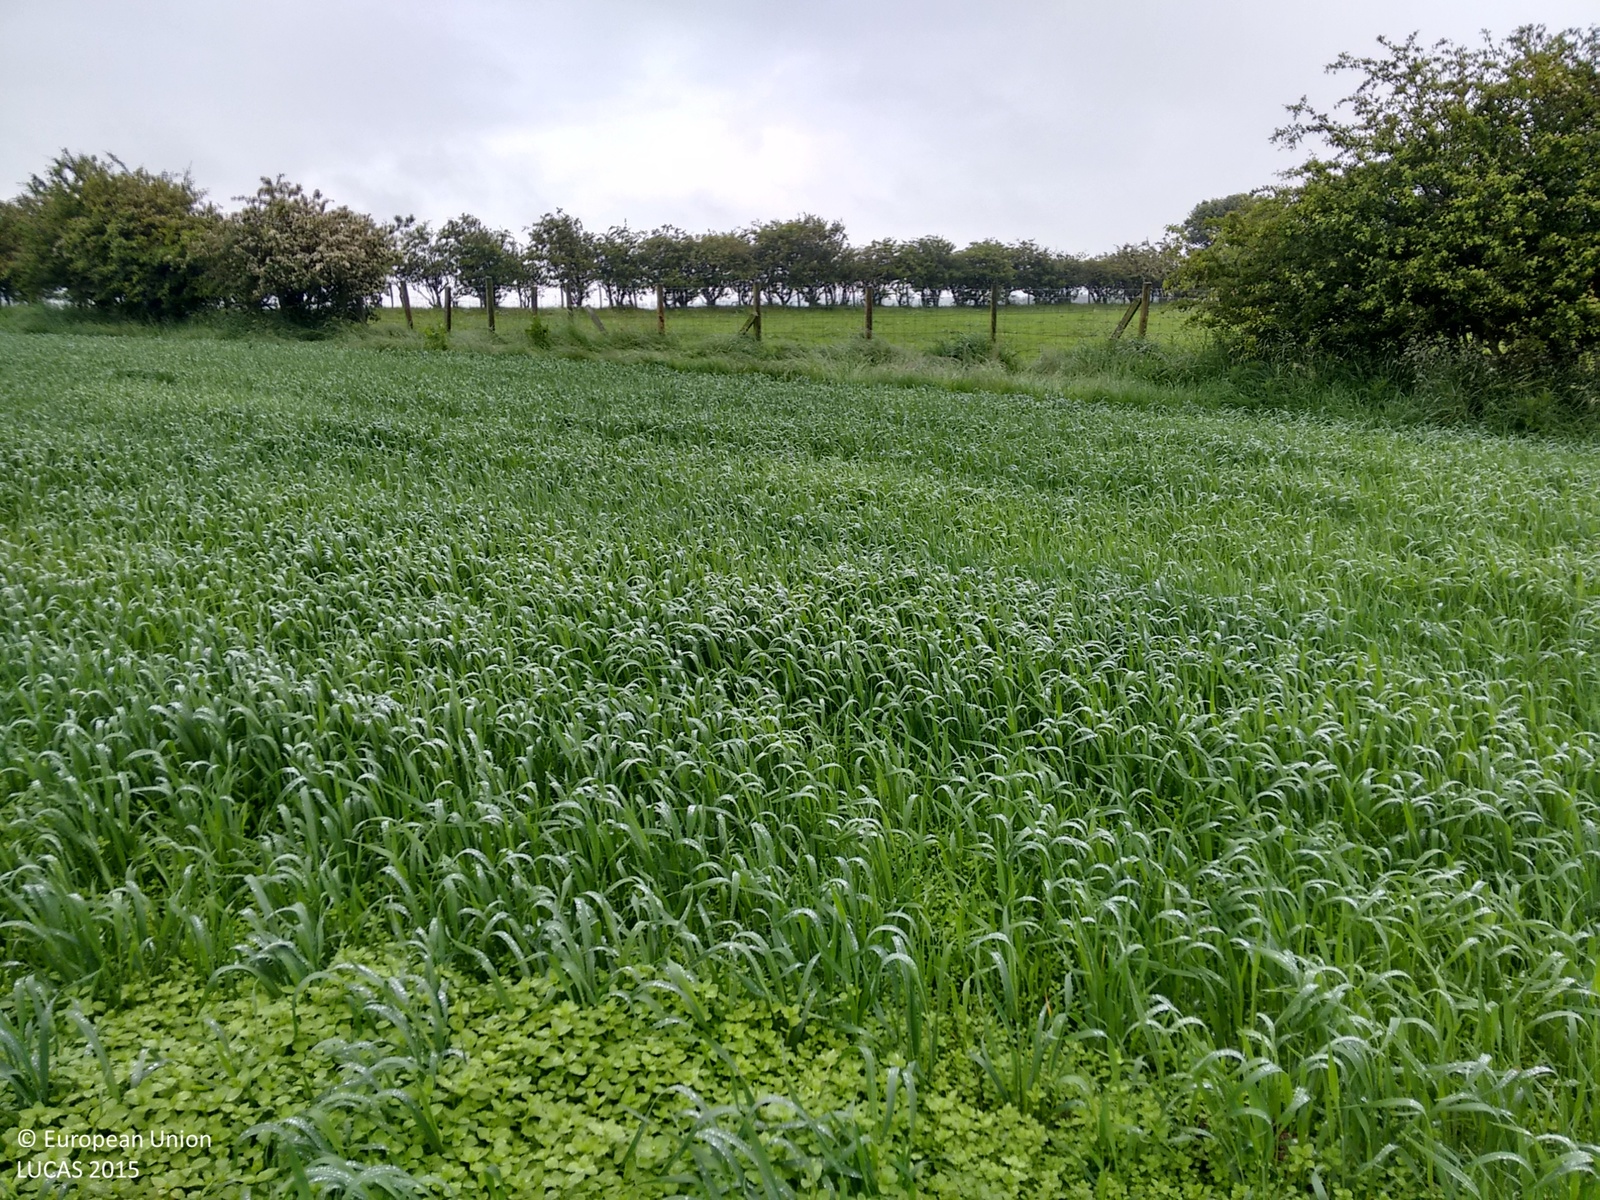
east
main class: Cropland
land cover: Barley
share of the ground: 50 - 75 %
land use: Agriculture (excluding fallow land and kitchen gardens)
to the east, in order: Barley; Abandoned hedges; Fences; Temporary grasslands; Fences; Broadleaved woodland; Grassland without tree/shrub cover
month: June
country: GB
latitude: 55.0705
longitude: -3.3099
